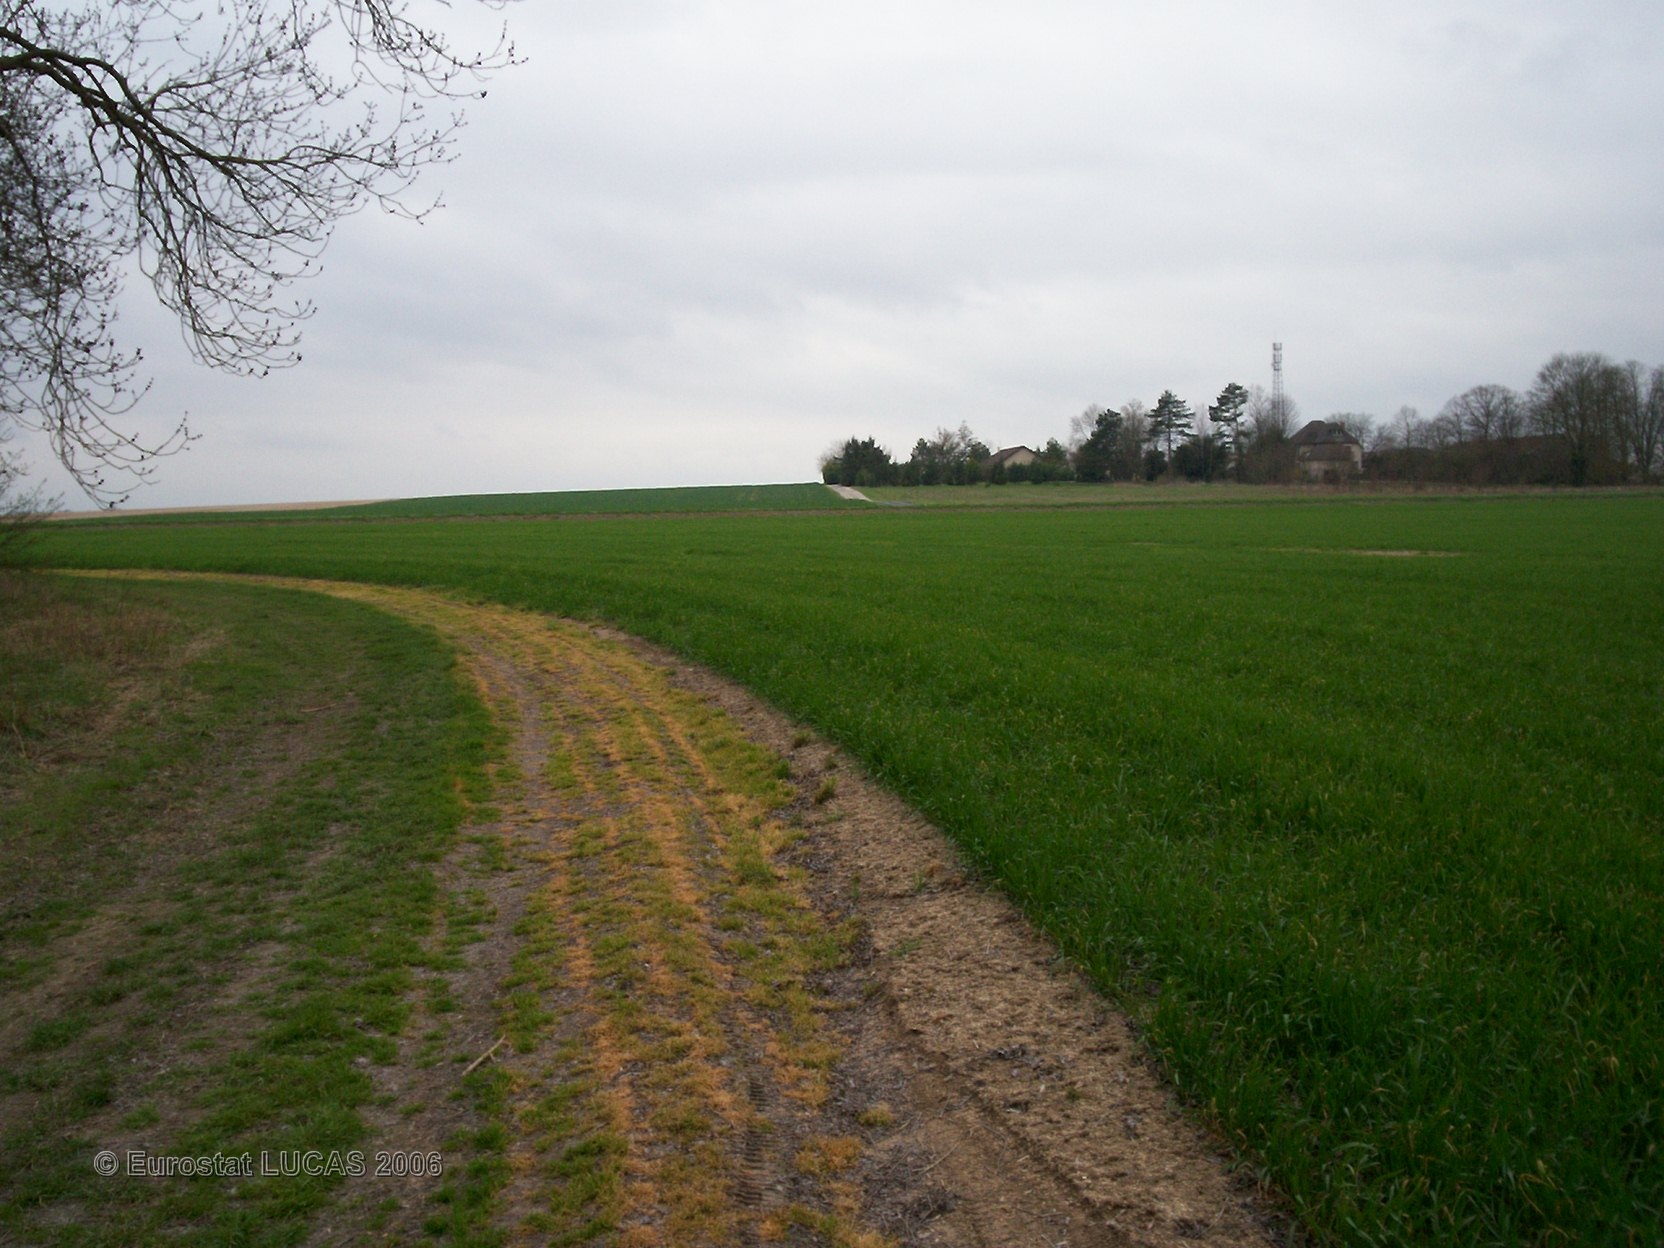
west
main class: Cropland
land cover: Common wheat
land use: Agriculture (excluding fallow land and kitchen gardens)
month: April
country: FR
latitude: 49.1833
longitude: 4.4400
